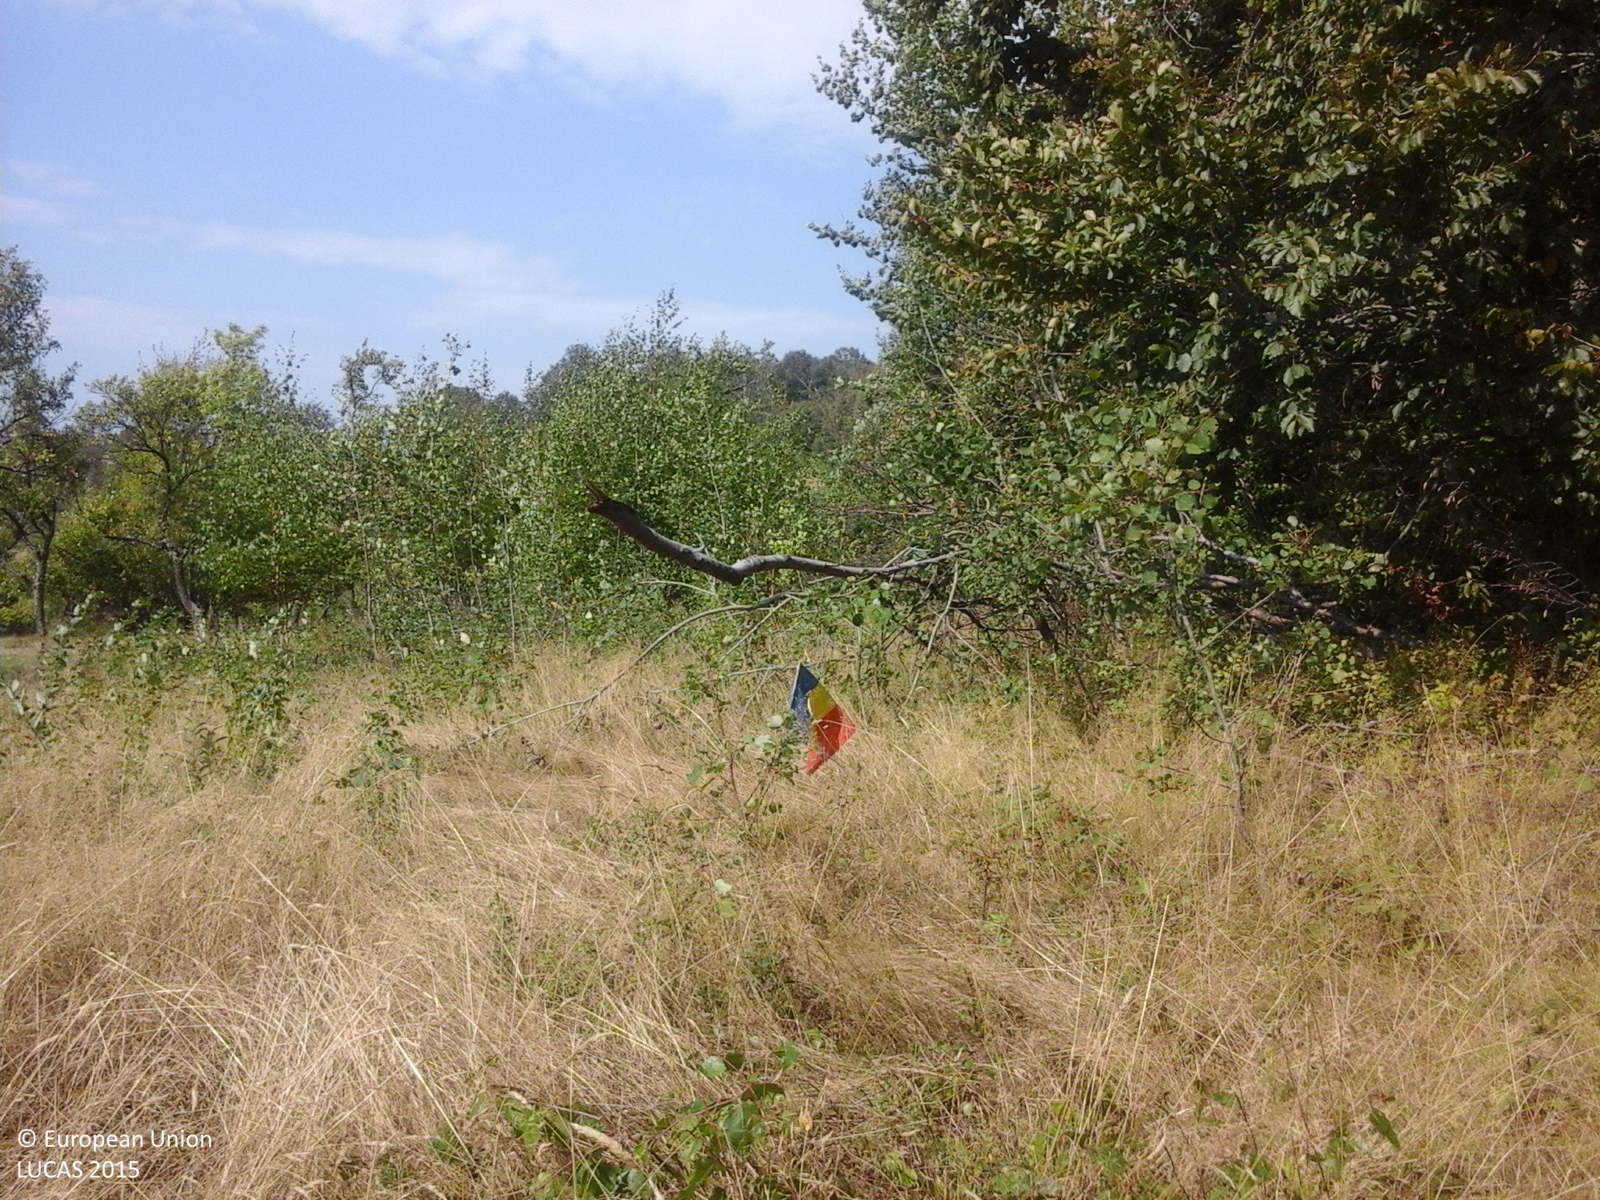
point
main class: Grassland
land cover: Grassland with sparse tree/shrub cover
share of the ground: > 75 %
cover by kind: herbaceous plants 90 %, broadleaved forest trees 5 %, shrubs 5 %
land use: Agriculture (excluding fallow land and kitchen gardens)
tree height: < 5 m
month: September
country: RO
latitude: 45.1745
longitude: 22.2167
